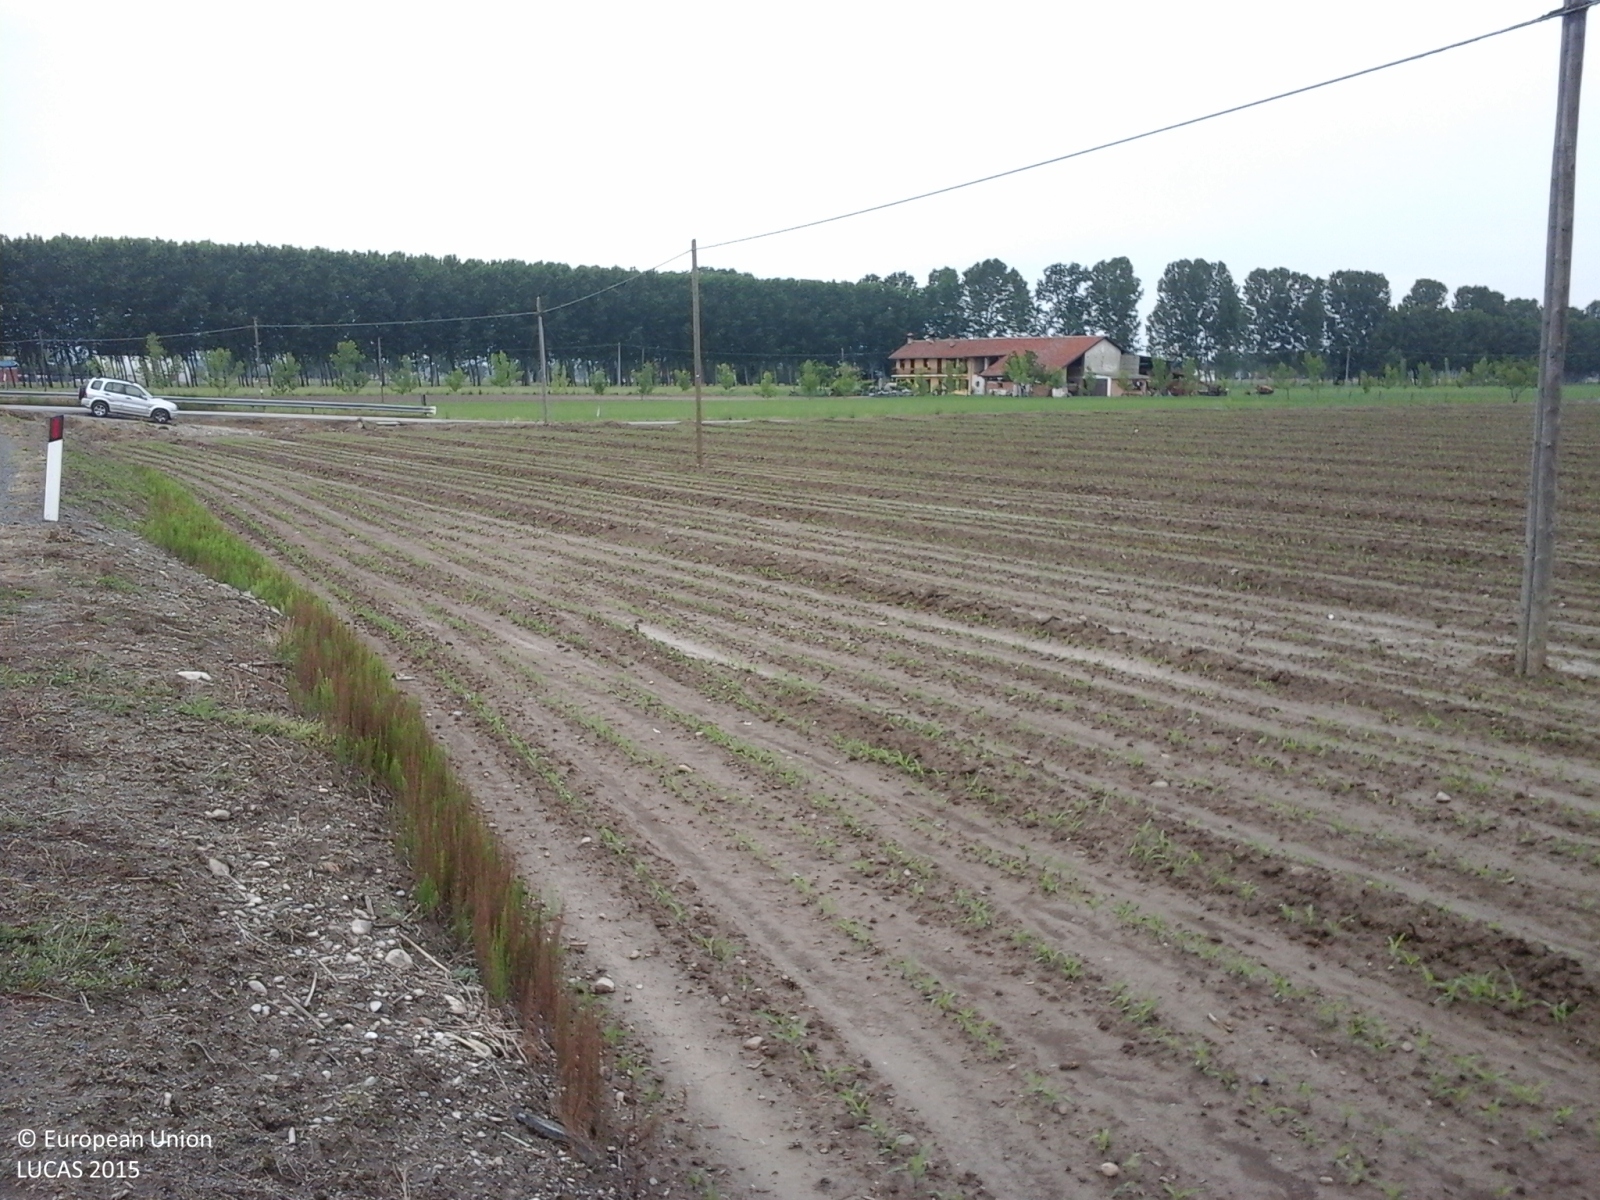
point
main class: Cropland
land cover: Maize
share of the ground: < 10 %
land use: Agriculture (excluding fallow land and kitchen gardens)
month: May
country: IT
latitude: 44.5585
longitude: 7.6505
